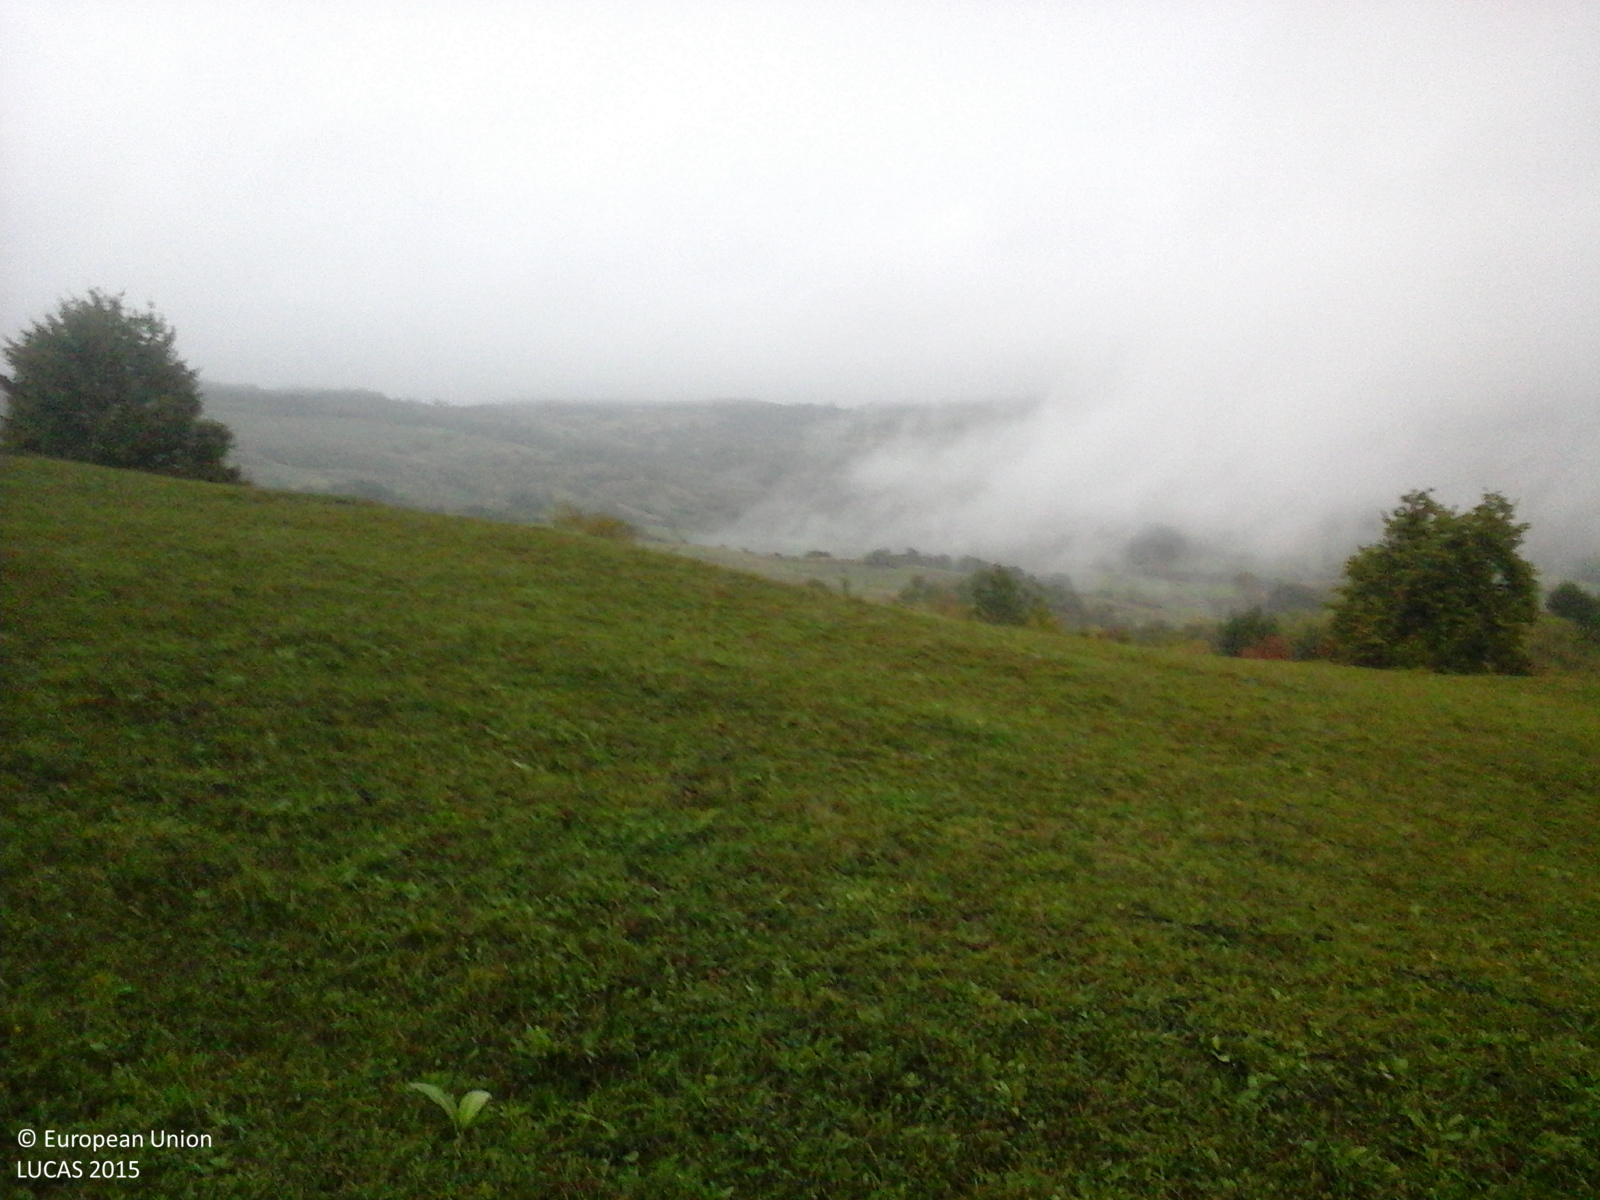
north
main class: Grassland
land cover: Grassland without tree/shrub cover
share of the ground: > 75 %
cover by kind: herbaceous plants 100 %
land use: Agriculture (excluding fallow land and kitchen gardens)
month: September
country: RO
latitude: 45.0998
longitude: 23.6971
